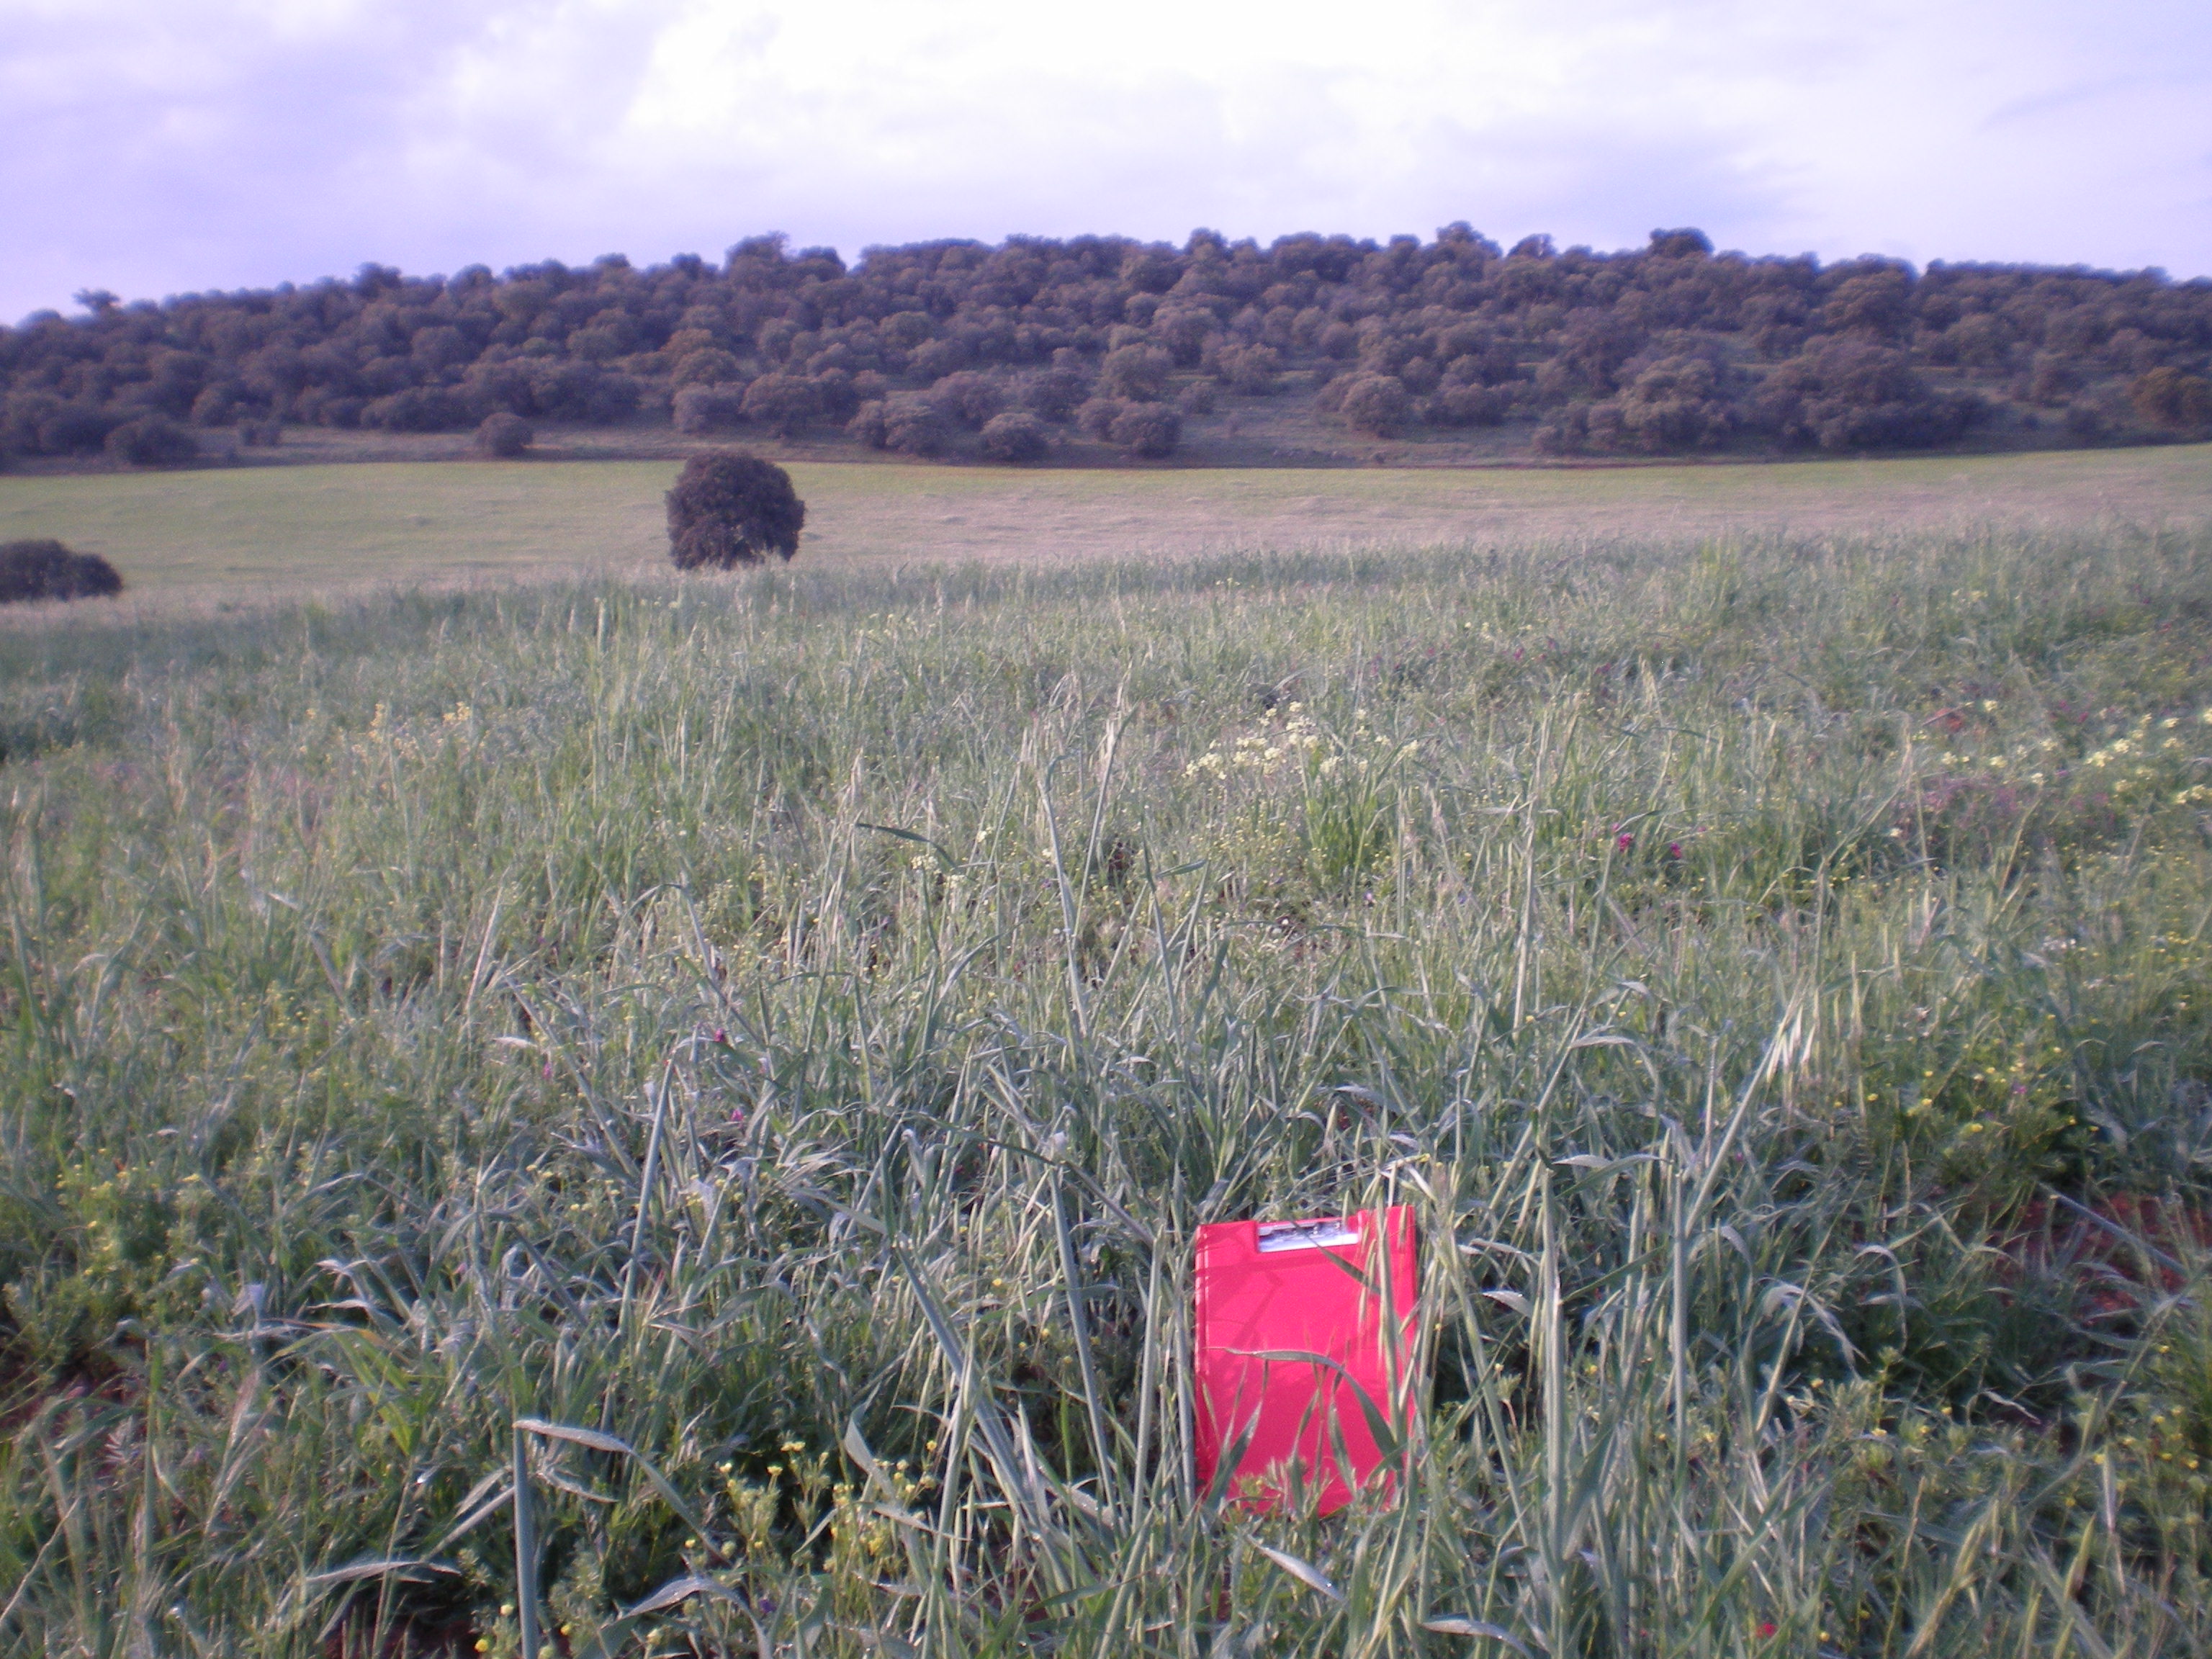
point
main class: Grassland
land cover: Spontaneously vegetated surfaces
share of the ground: > 75 %
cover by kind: herbaceous plants 95 %, unconsolidated bare surface 5 %
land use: Fallow land
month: April
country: ES
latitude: 38.7599
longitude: -3.5111
